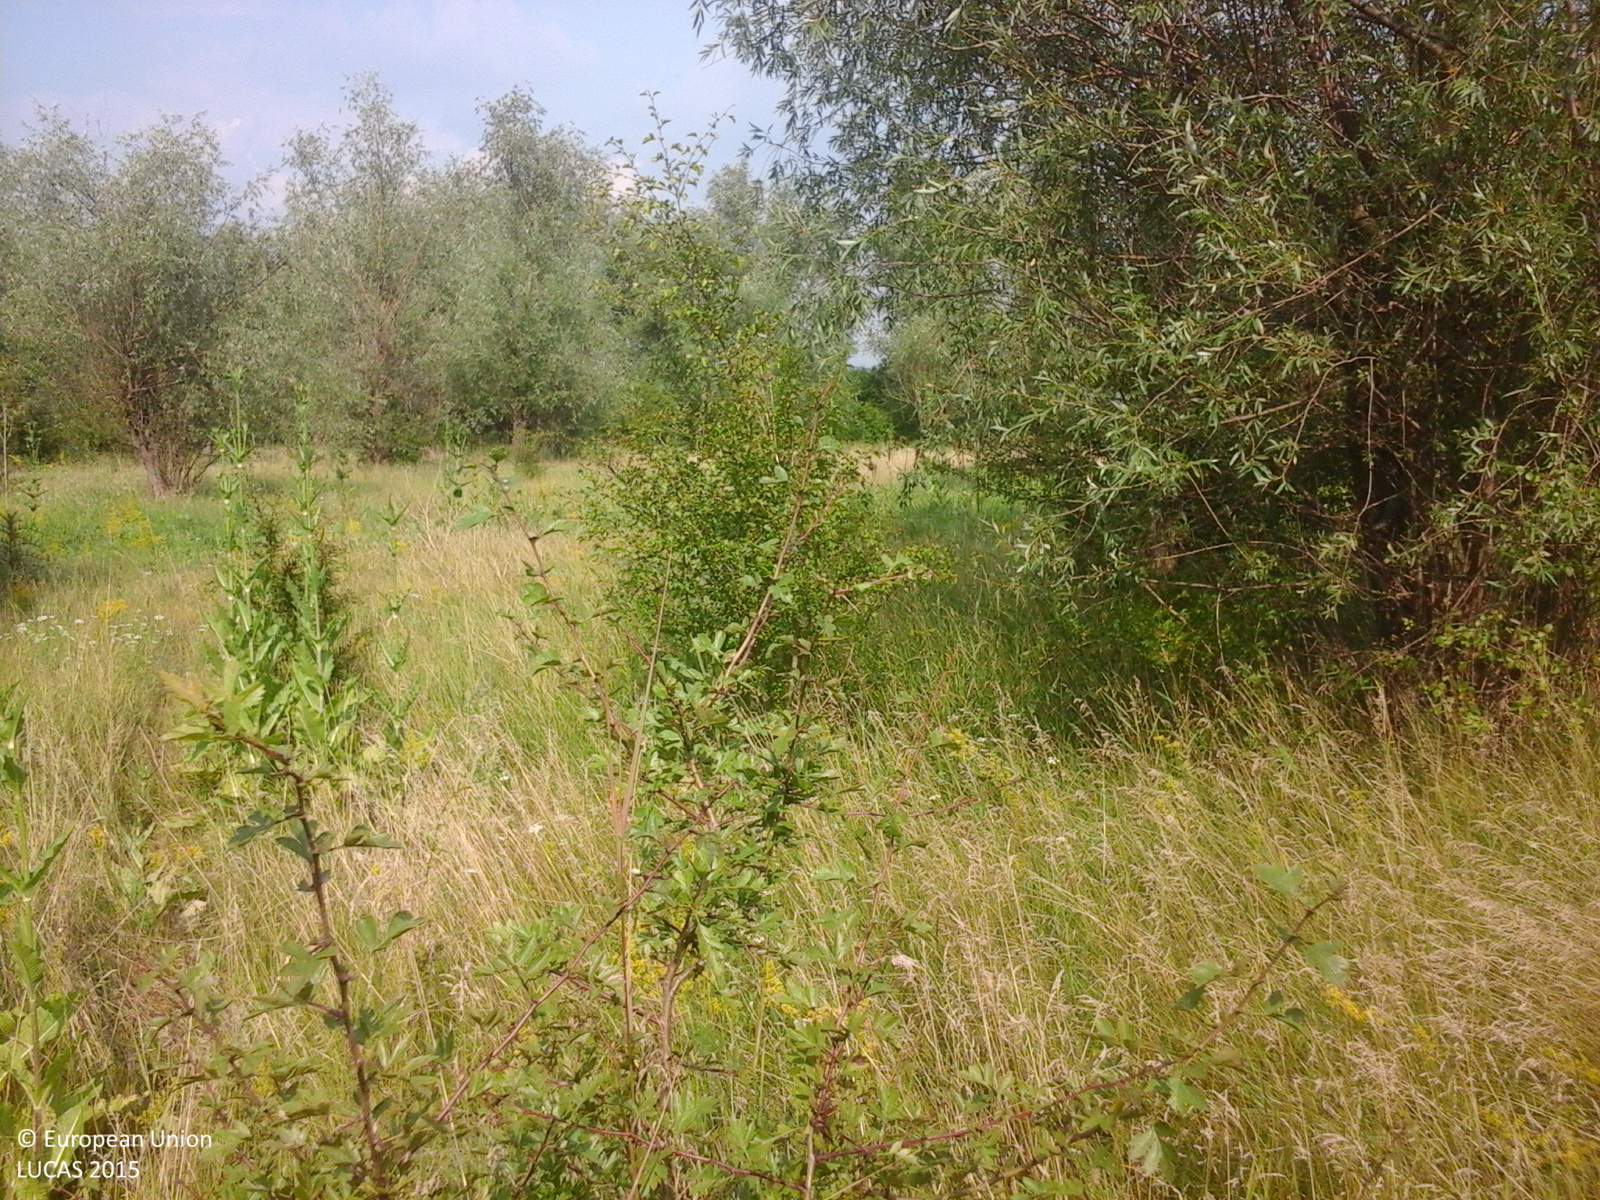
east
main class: Grassland
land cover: Grassland with sparse tree/shrub cover
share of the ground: > 75 %
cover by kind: herbaceous plants 85 %, shrubs 10 %, broadleaved forest trees 5 %
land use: Agriculture (excluding fallow land and kitchen gardens)
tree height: > 5 m
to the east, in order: Grassland with sparse tree/shrub cover; Tracks; Grassland with sparse tree/shrub cover; Spontaneously vegetated surfaces; Tracks; Grass margins; Ditches and canals; Spontaneously vegetated surfaces; Tracks; Spontaneously vegetated surfaces; Ditches and canals; Abandoned hedges; Spontaneously vegetated surfaces; Other fresh vegetables; Tracks; Other fresh vegetables
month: July
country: RO
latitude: 43.8237
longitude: 24.7290
